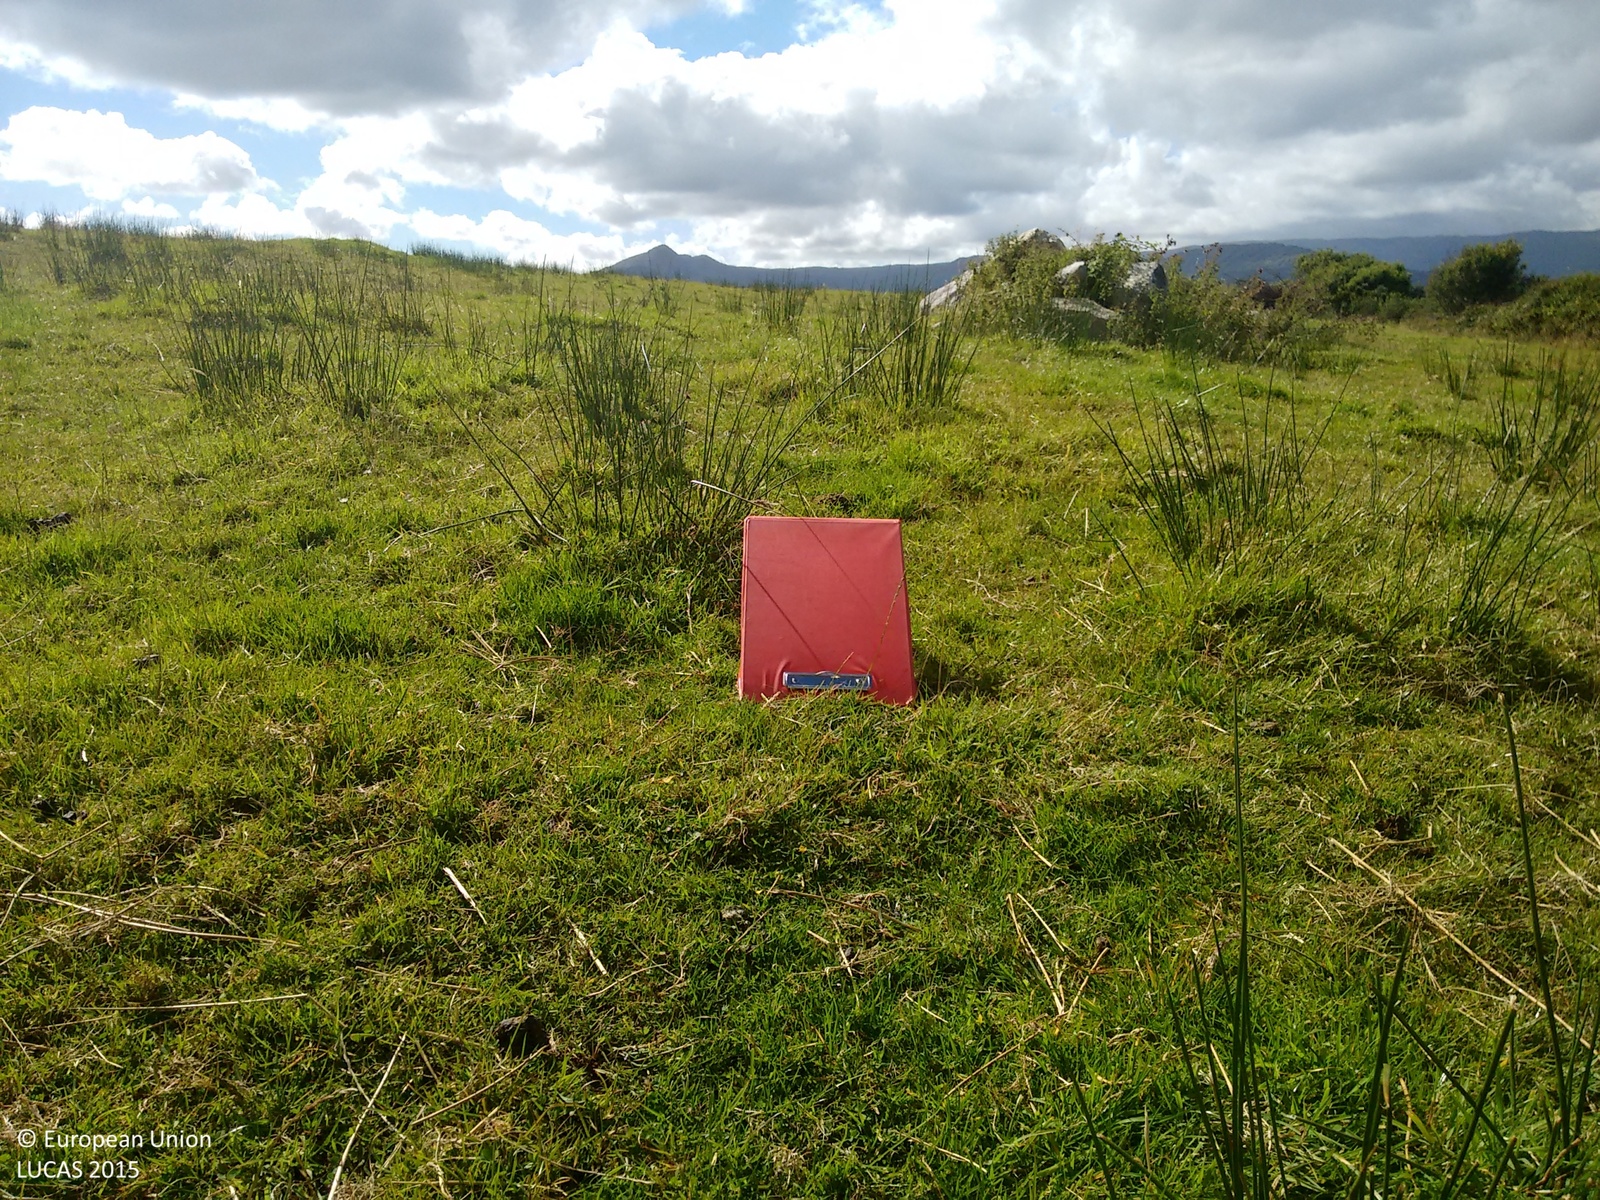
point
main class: Grassland
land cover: Grassland without tree/shrub cover
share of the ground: > 75 %
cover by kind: herbaceous plants 100 %
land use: Agriculture (excluding fallow land and kitchen gardens)
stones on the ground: < 10 %
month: August
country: IE
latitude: 51.7186
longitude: -9.4990
